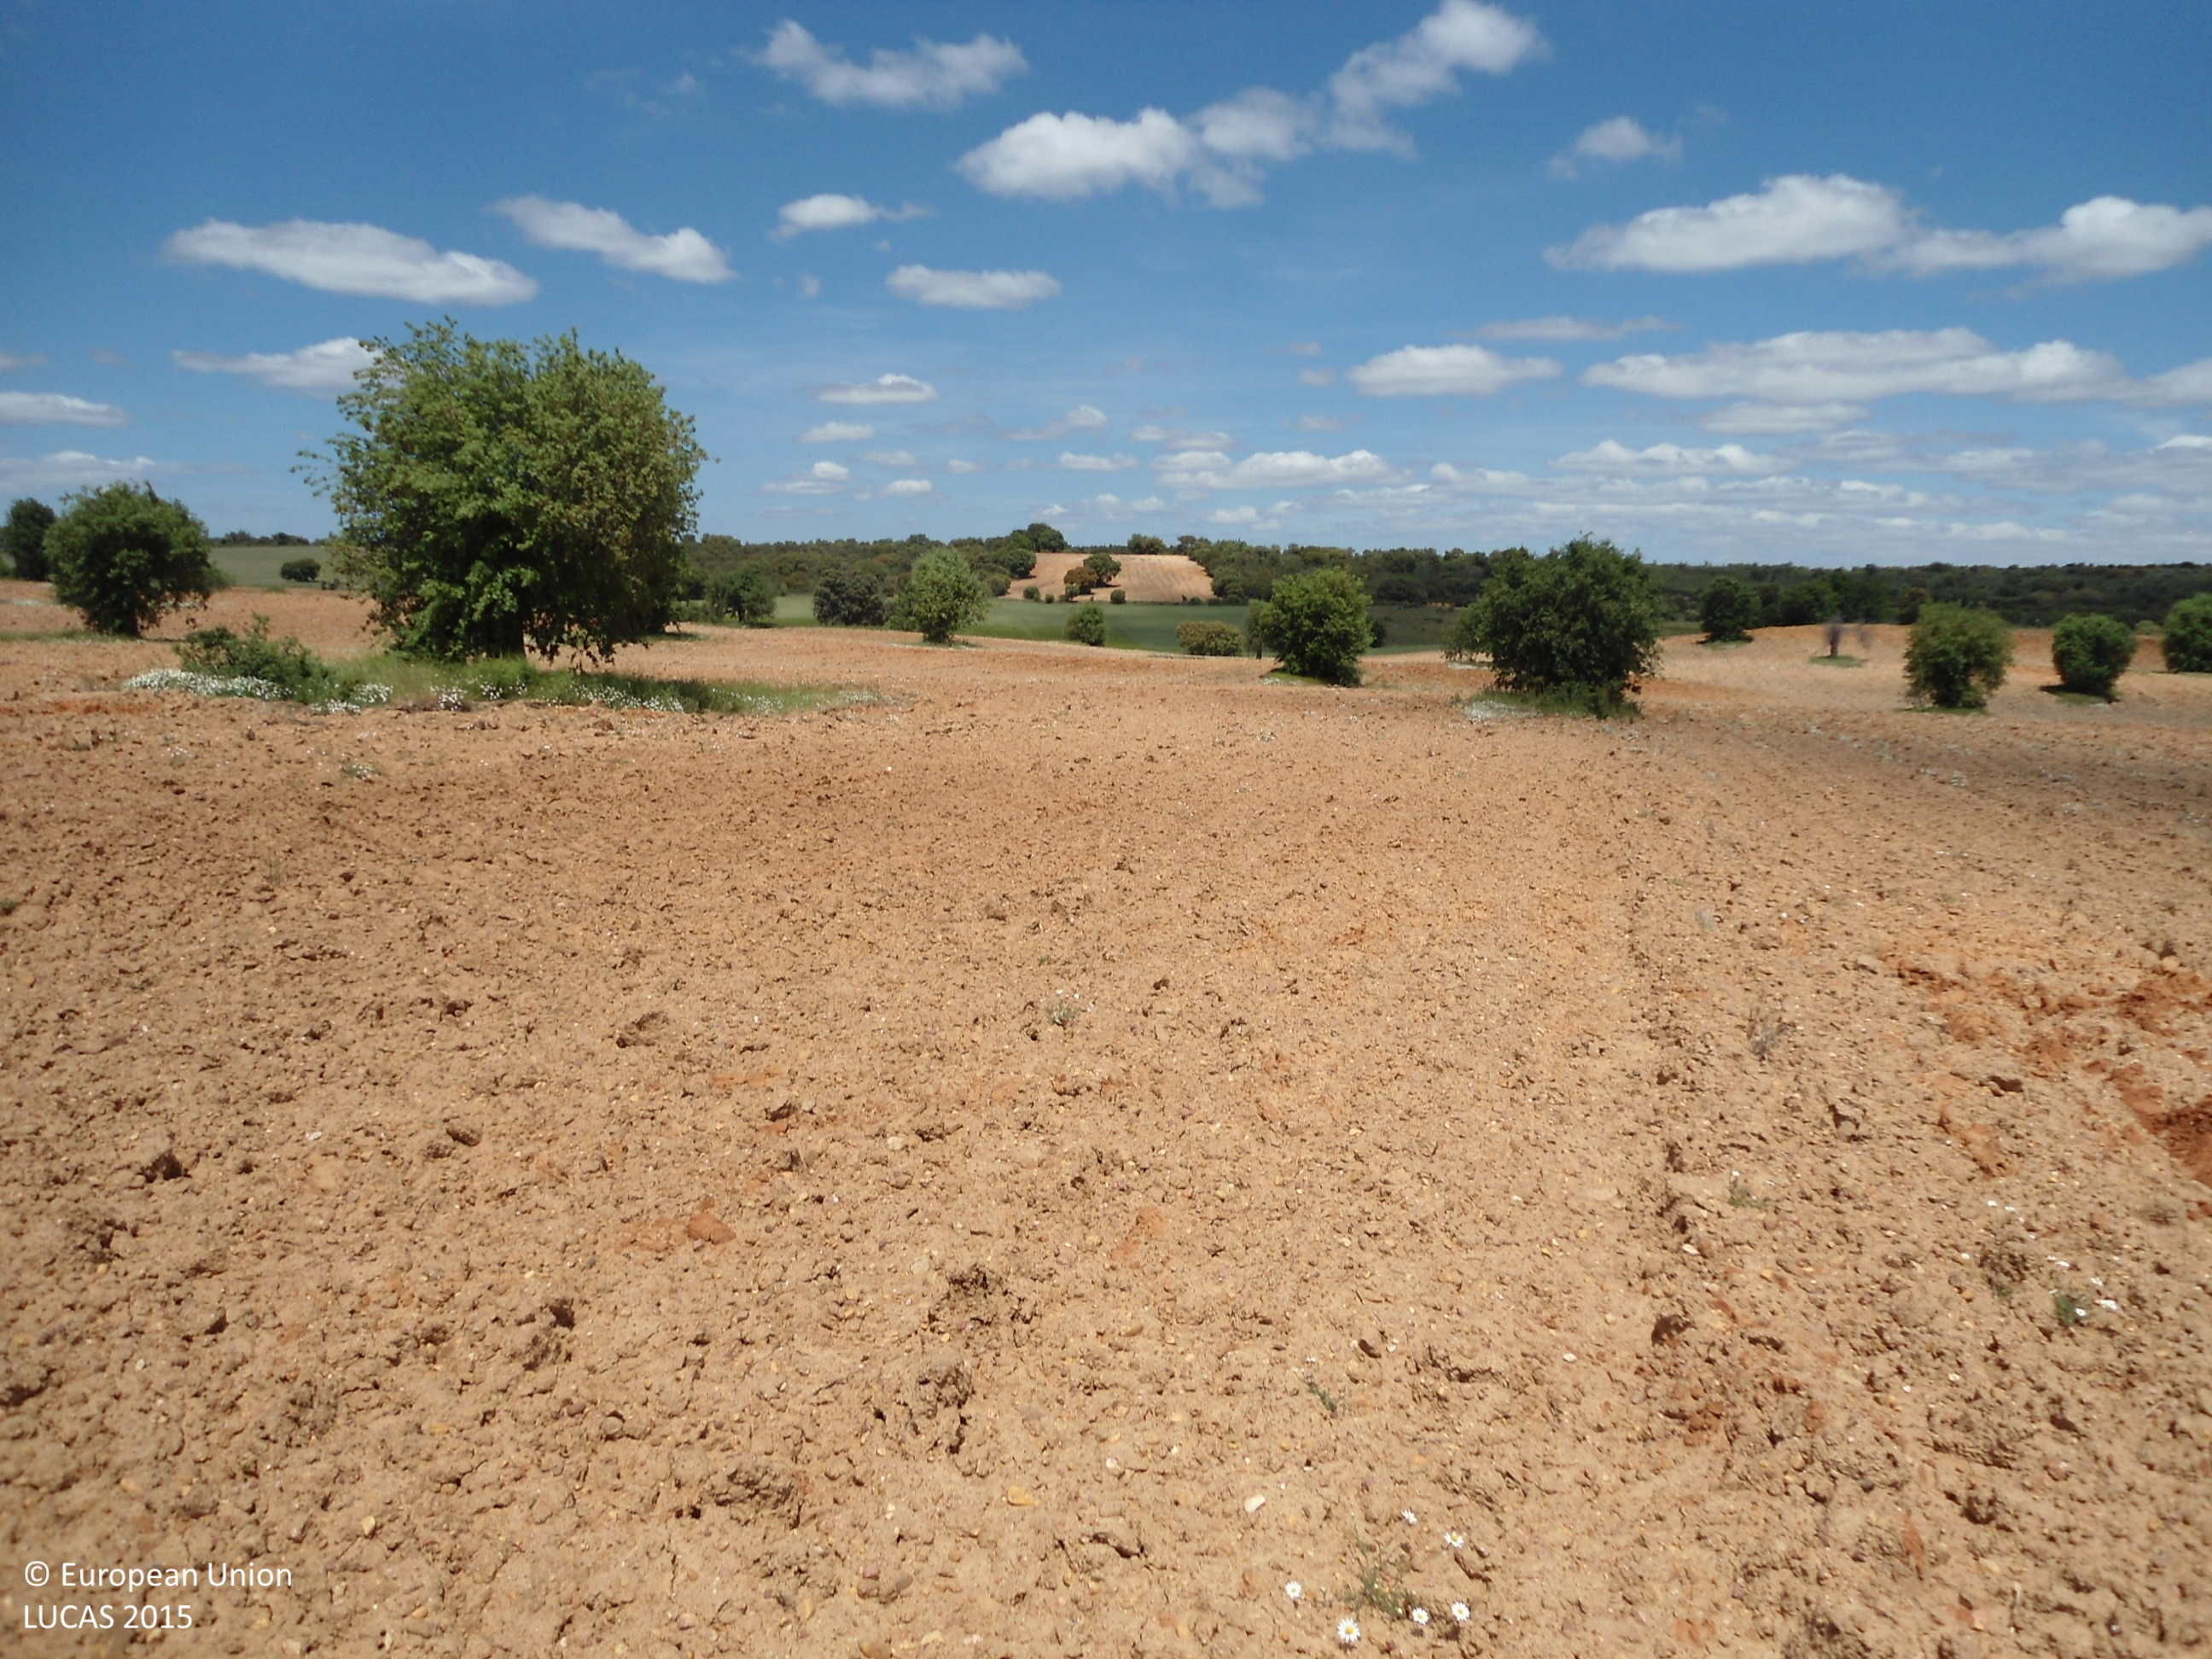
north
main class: Woodland
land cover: Broadleaved woodland
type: broadleaved evergreen forest
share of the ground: 25 - 50 %
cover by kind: unconsolidated bare surface 70 %, broadleaved forest trees 30 %
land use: Forestry
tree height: > 5 m
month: May
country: ES
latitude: 41.8857
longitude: -5.8940
